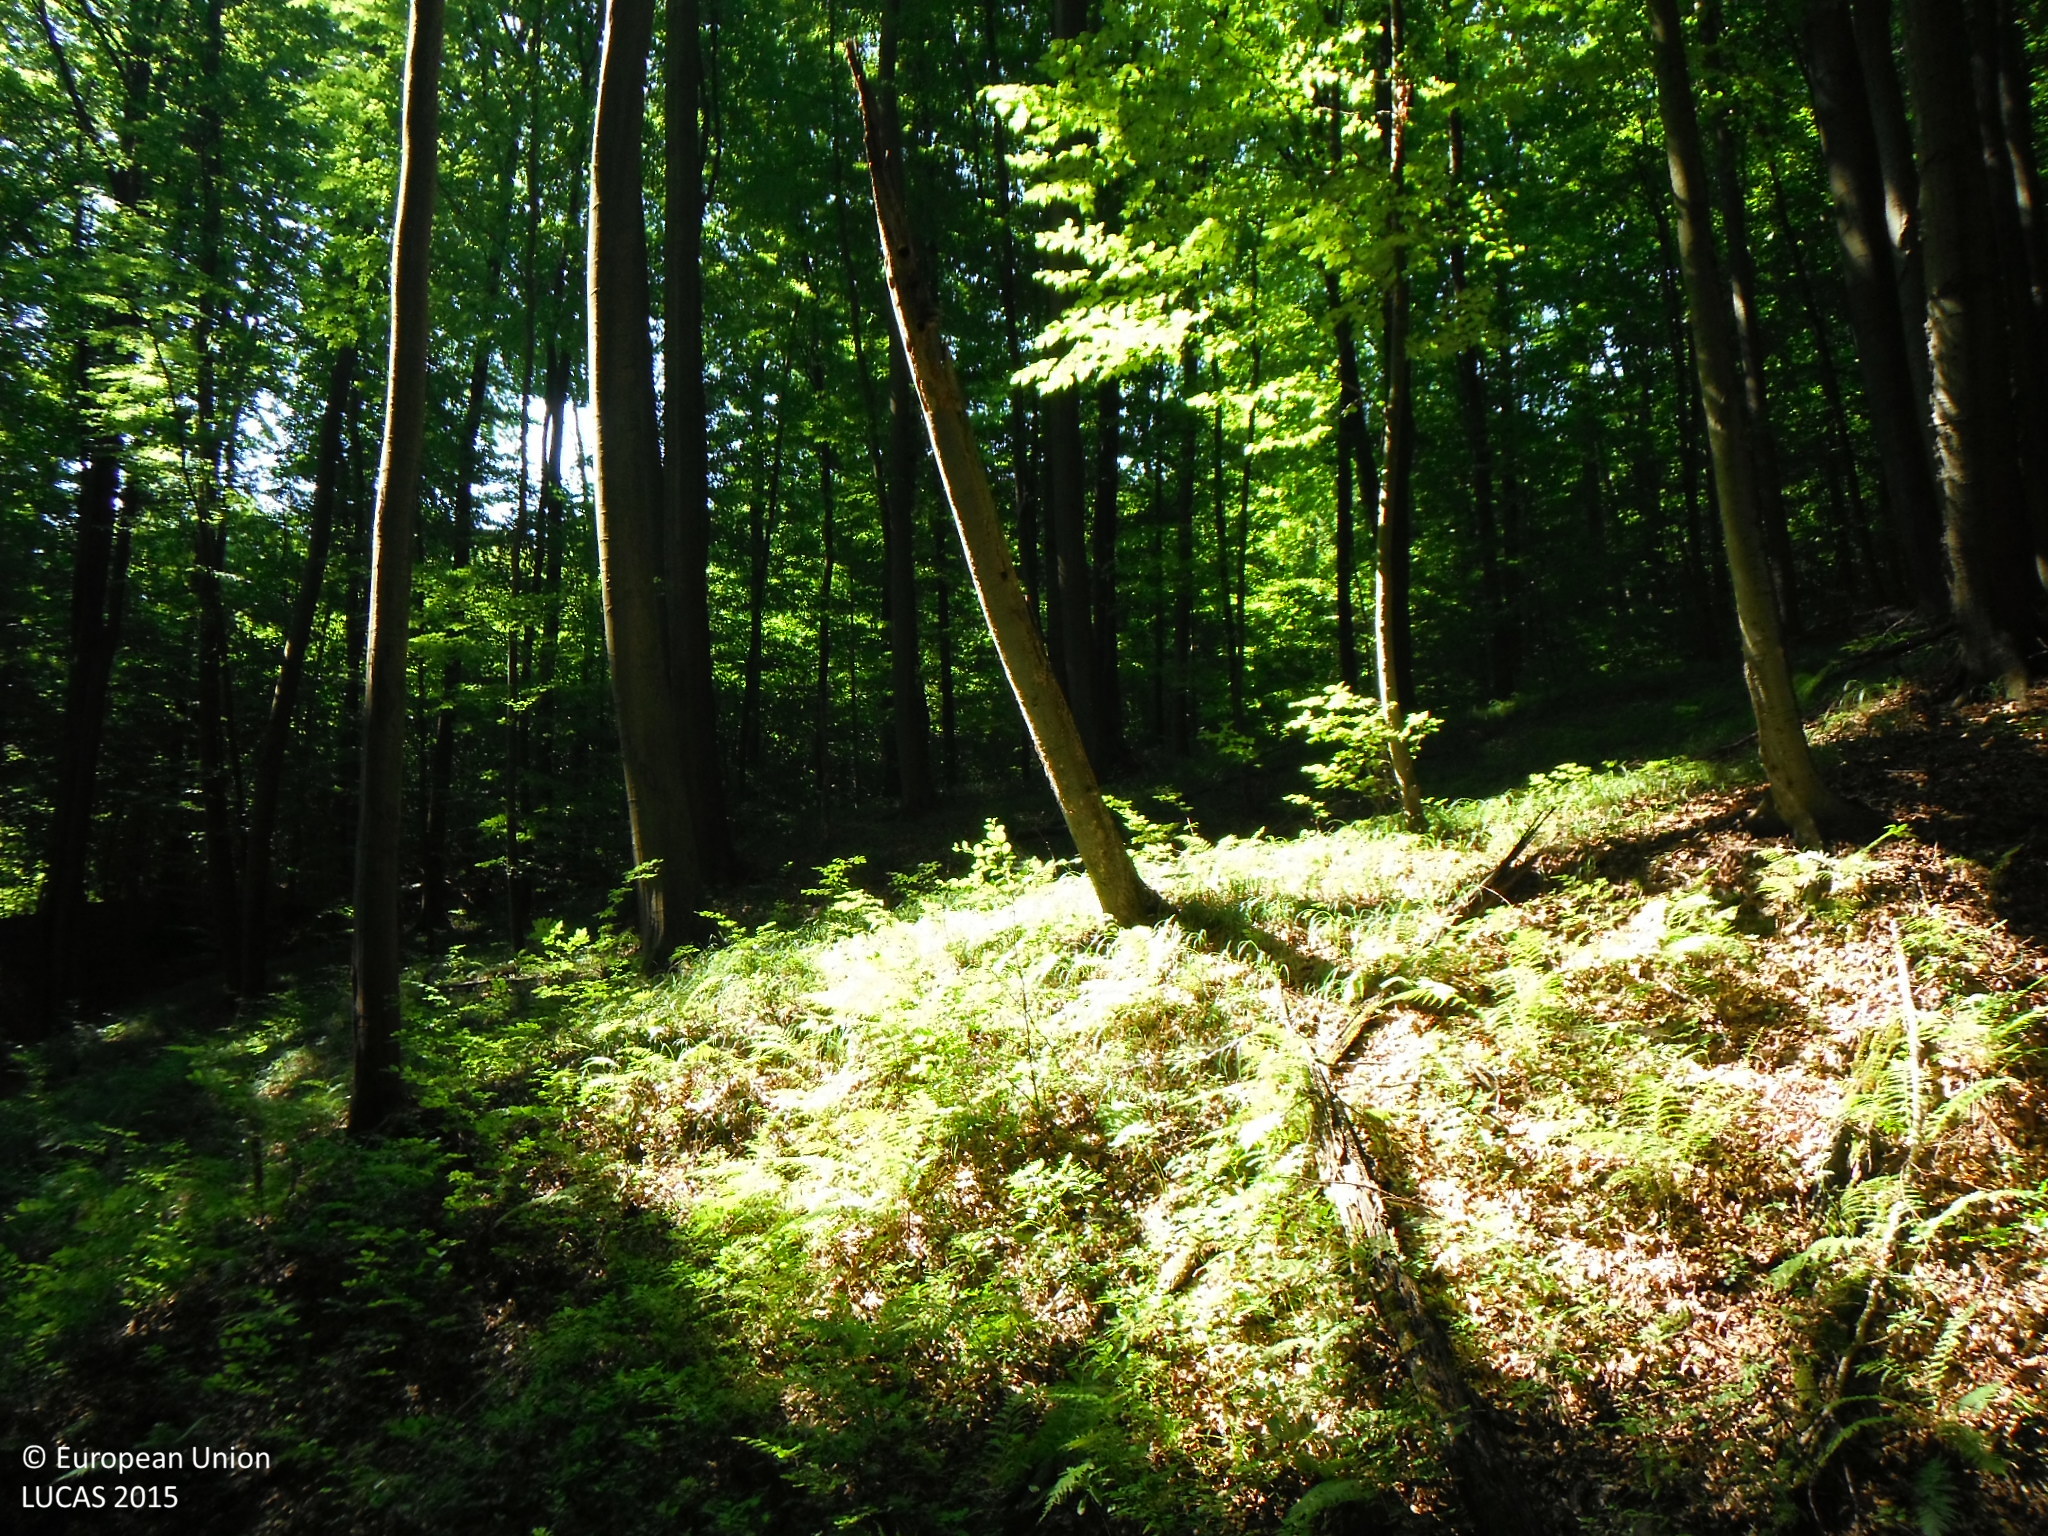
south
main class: Woodland
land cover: Broadleaved woodland
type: beech forest
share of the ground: > 75 %
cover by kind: broadleaved forest trees 90 %, herbaceous plants 10 %
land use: Forestry
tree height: > 5 m
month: July
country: SK
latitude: 49.2612
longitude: 21.4395
